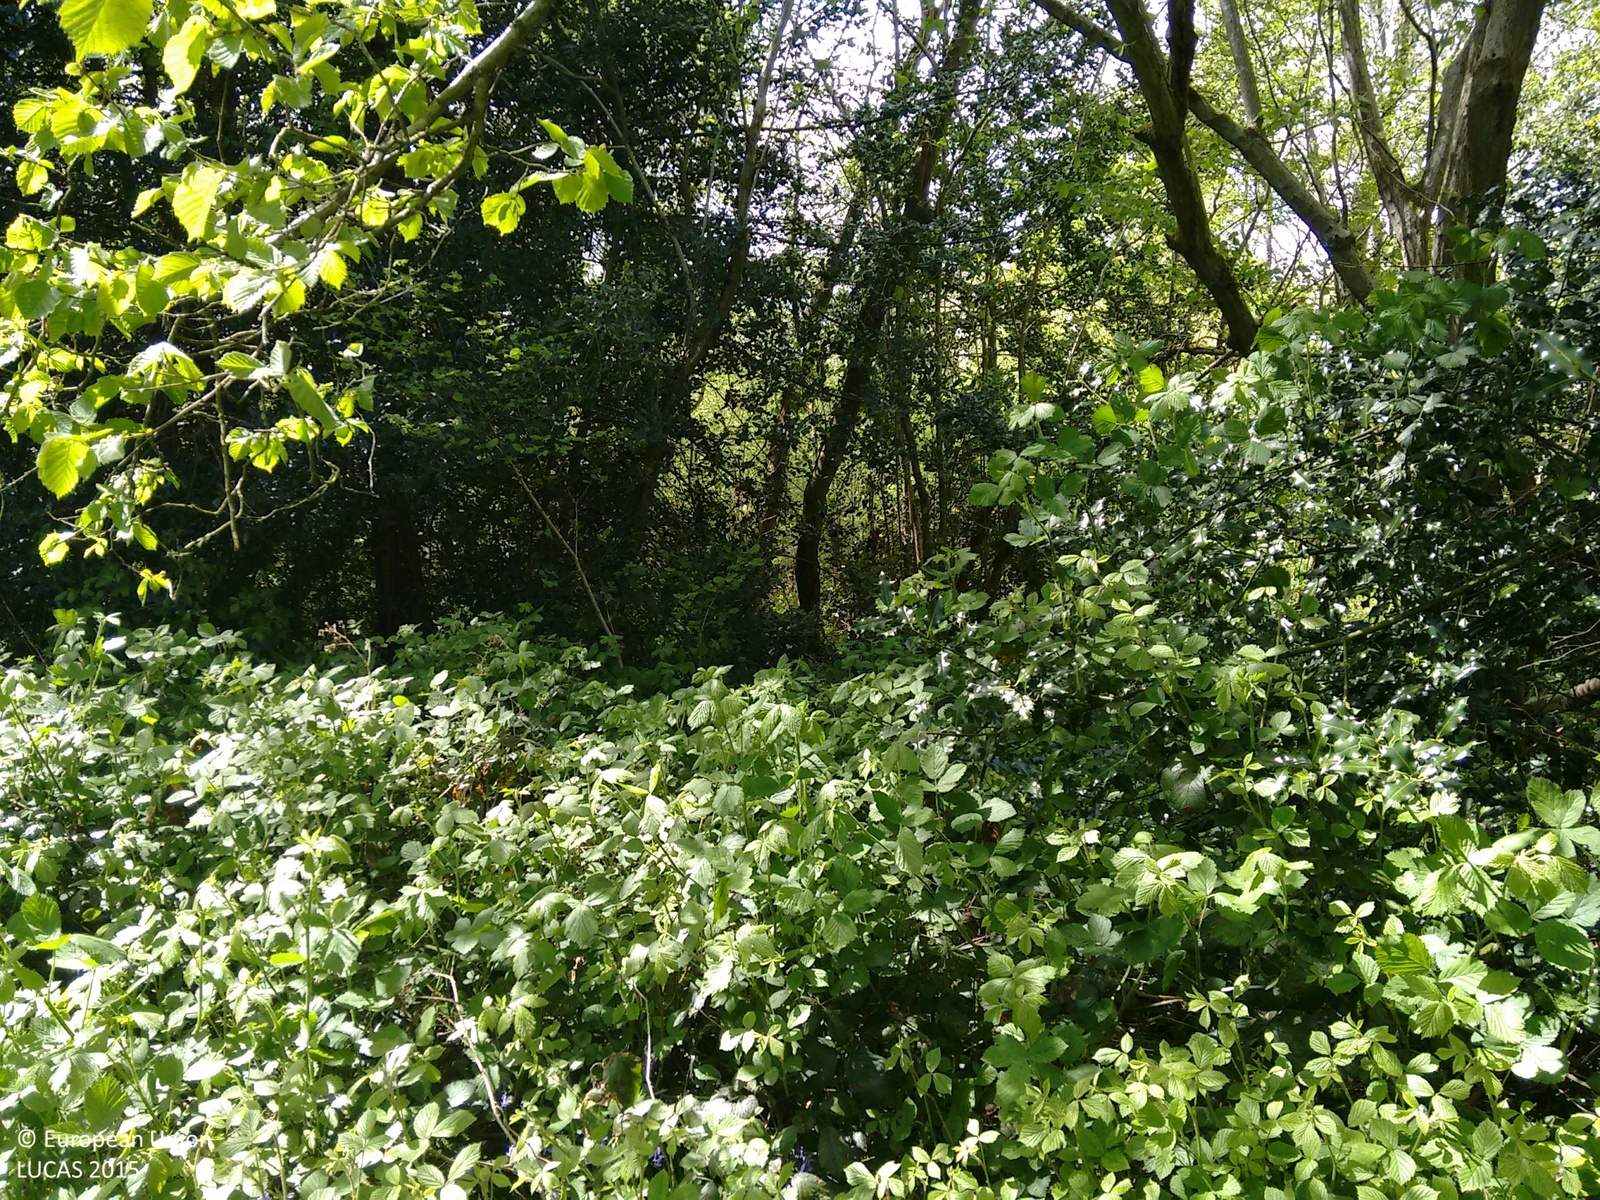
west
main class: Woodland
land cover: Broadleaved woodland
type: mesophytic deciduous forest
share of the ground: > 75 %
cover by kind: broadleaved forest trees 100 %
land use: Amenities, museums, leisure
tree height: > 5 m
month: May
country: GB
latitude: 50.8280
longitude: -1.3930
